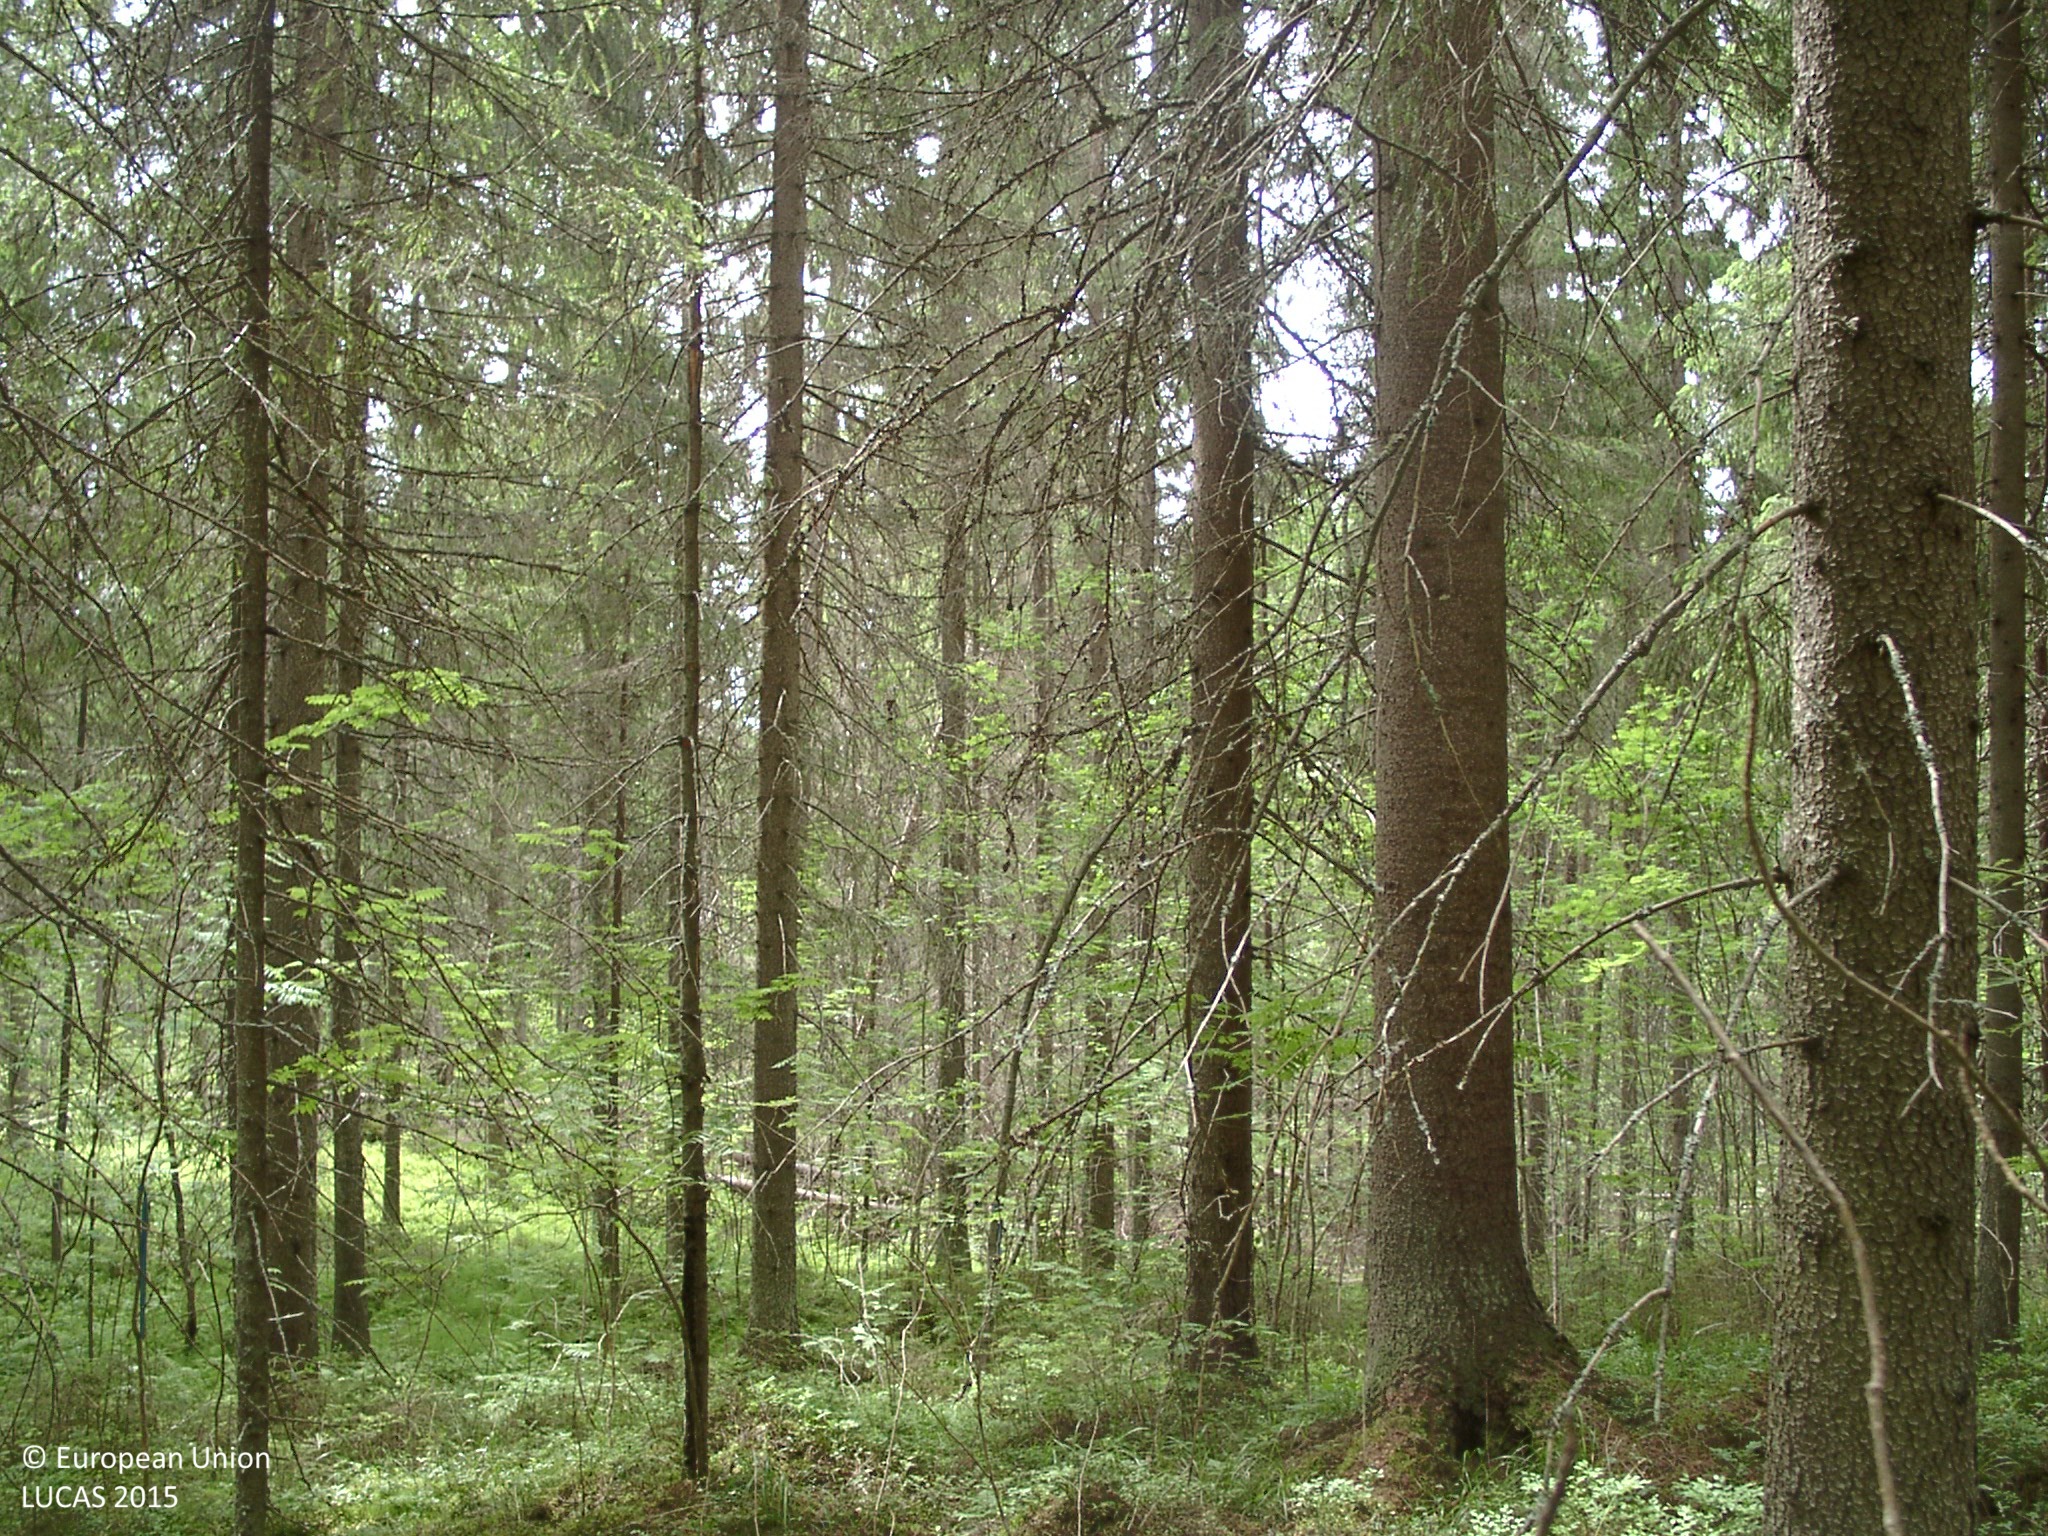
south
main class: Woodland
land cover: Spruce dominated coniferous woodland
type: boreal forest
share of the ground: 50 - 75 %
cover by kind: coniferous forest trees 60 %, shrubs 20 %, broadleaved forest trees 10 %, lichens and mosses 10 %
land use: Forestry
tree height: > 5 m
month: July
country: FI
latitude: 61.9907
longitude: 25.2865
